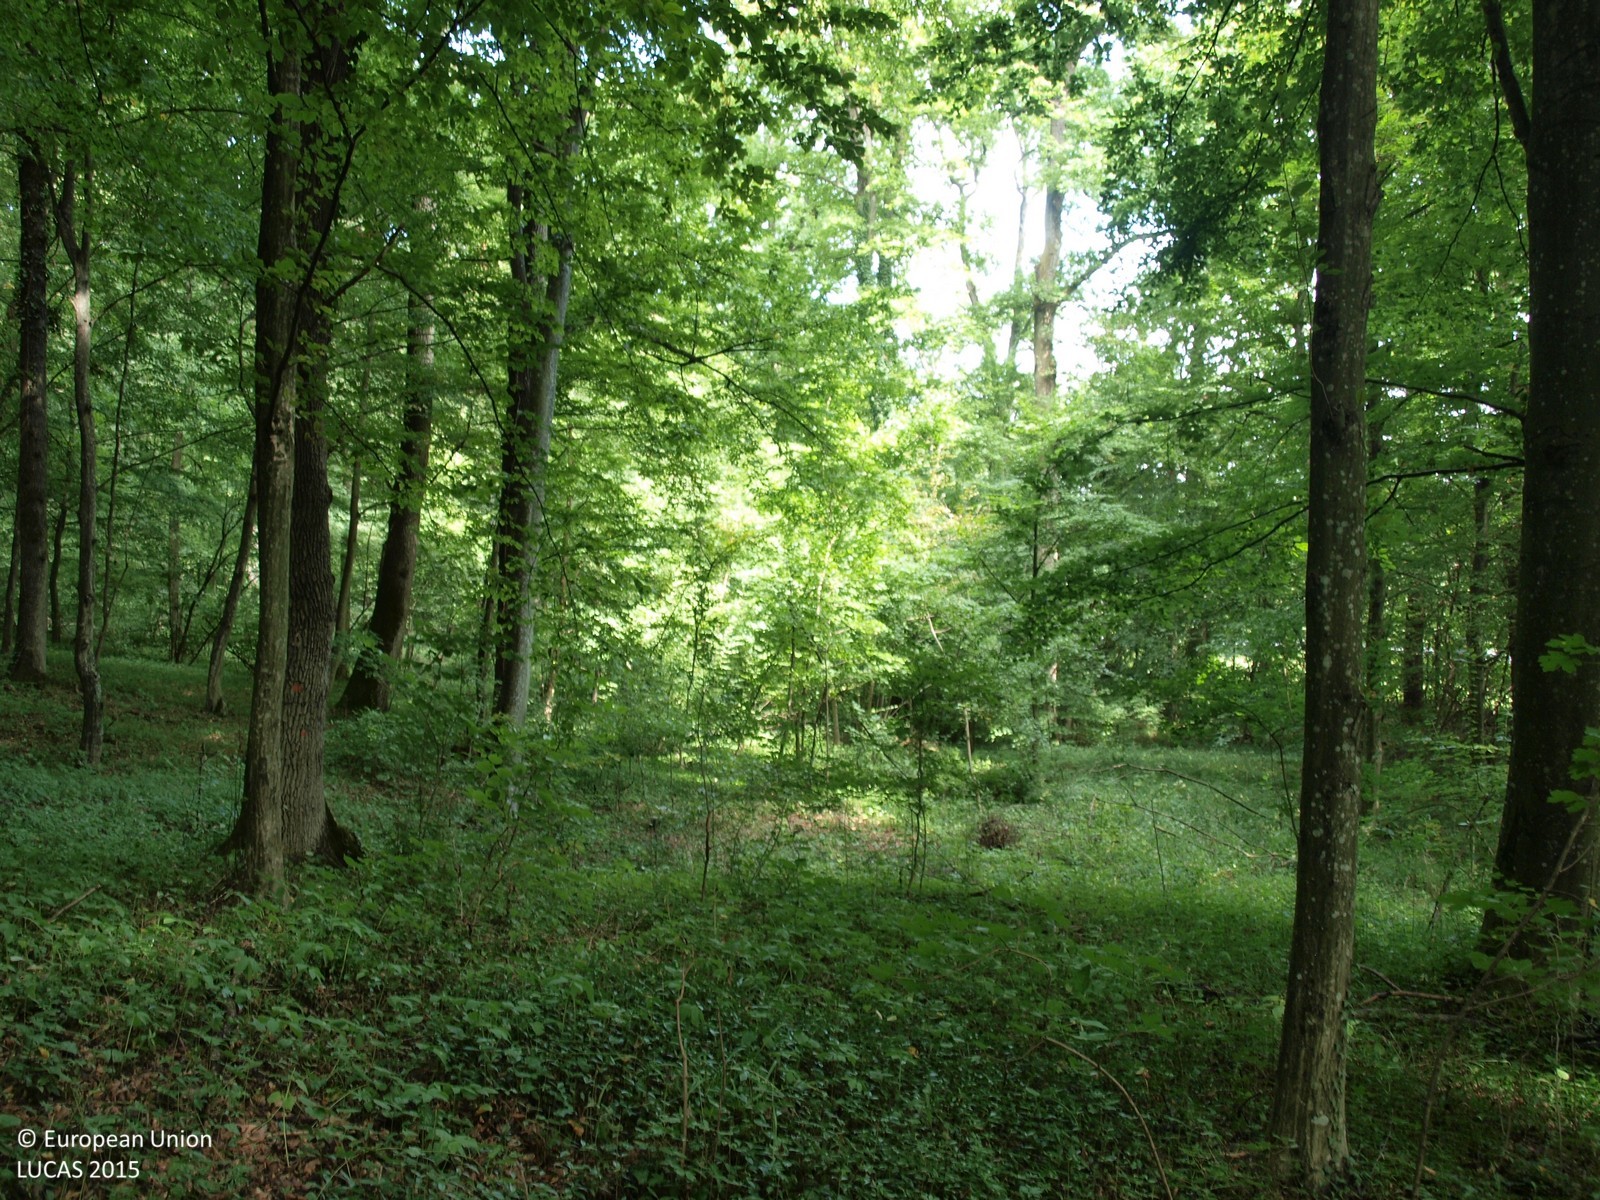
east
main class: Woodland
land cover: Broadleaved woodland
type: mesophytic deciduous forest
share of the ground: > 75 %
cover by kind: broadleaved forest trees 100 %
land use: Forestry
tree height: > 5 m
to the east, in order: Broadleaved woodland; Grassland without tree/shrub cover; Ditches and canals; Paved roads, cycling and walking lanes; Grassland without tree/shrub cover; Electric lines; Grassland without tree/shrub cover
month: August
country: HR
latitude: 46.0224
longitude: 16.5751
